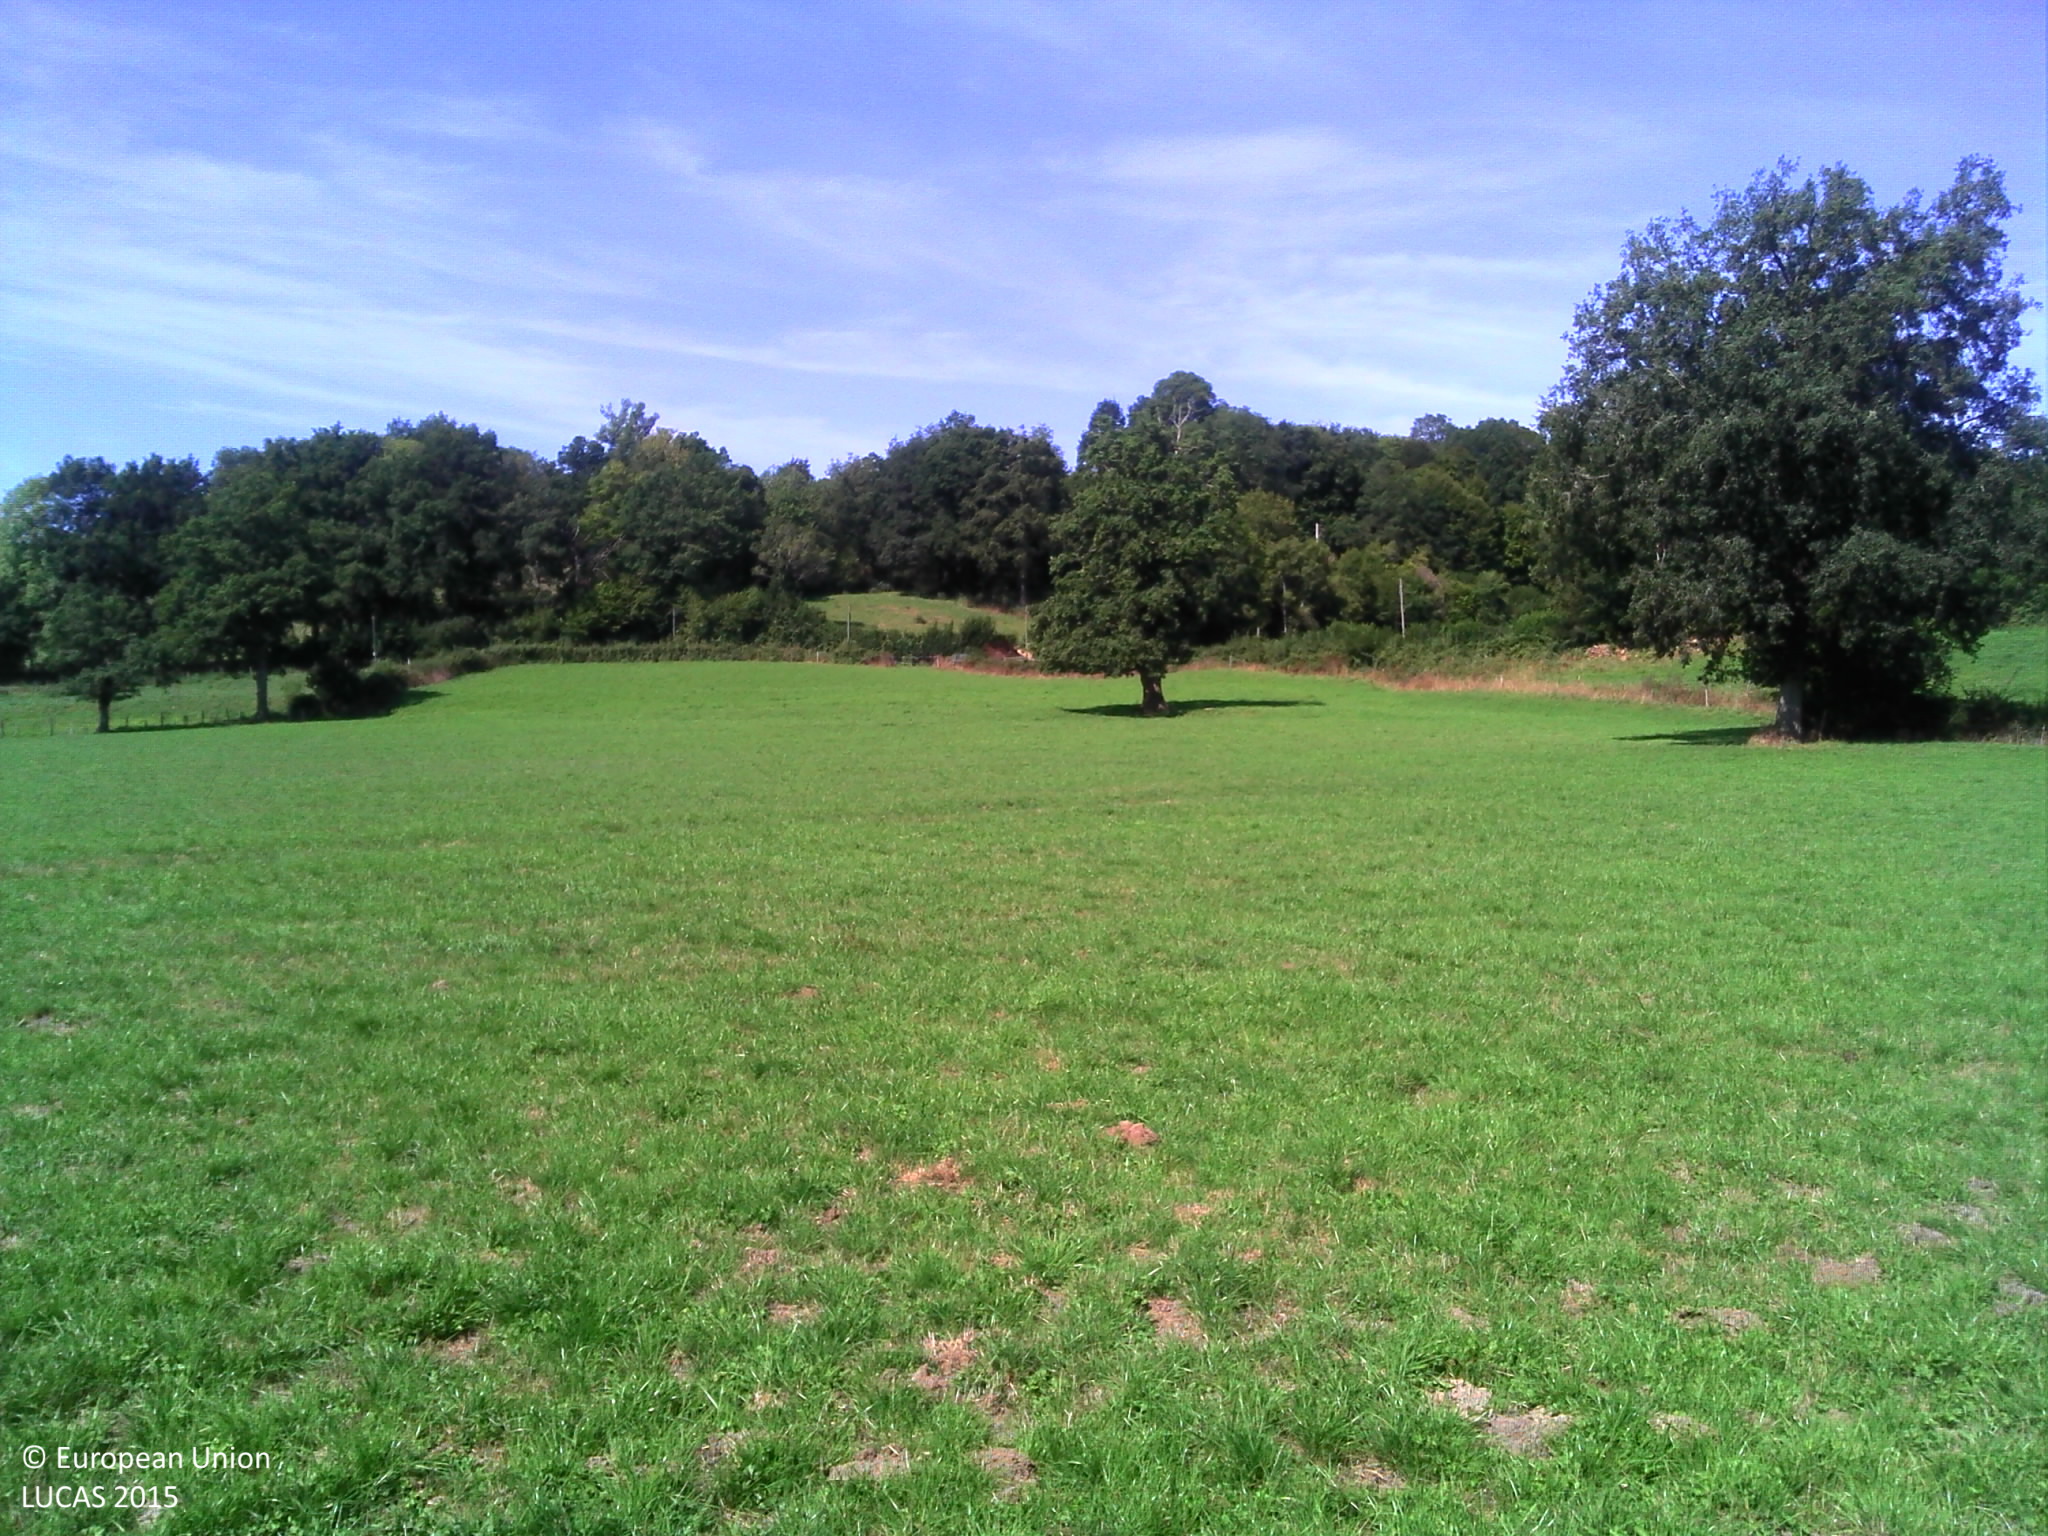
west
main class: Grassland
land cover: Grassland without tree/shrub cover
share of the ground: > 75 %
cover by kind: herbaceous plants 100 %
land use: Agriculture (excluding fallow land and kitchen gardens)
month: August
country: FR
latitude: 45.9464
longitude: 2.2947
